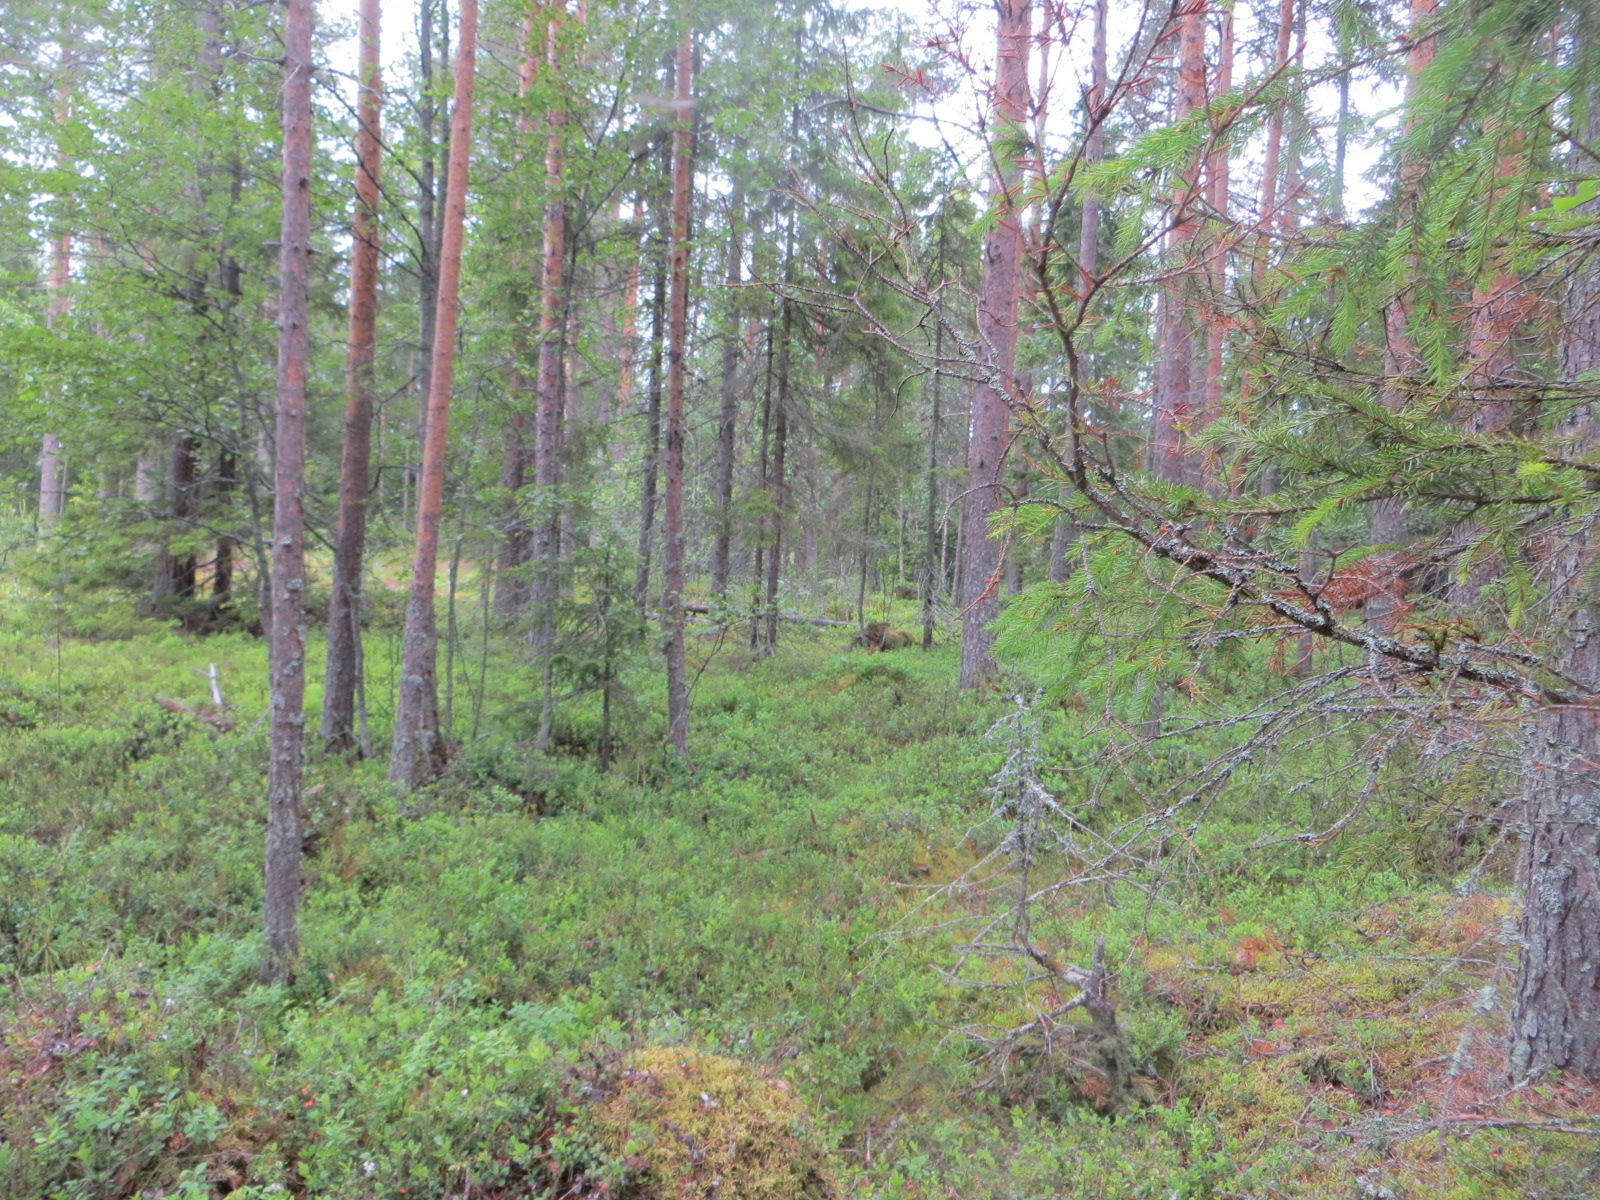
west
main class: Woodland
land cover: Pine dominated coniferous woodland
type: boreal forest
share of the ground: 50 - 75 %
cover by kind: coniferous forest trees 65 %, shrubs 30 %, broadleaved forest trees 5 %
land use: Forestry
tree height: > 5 m
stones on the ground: < 10 %
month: July
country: FI
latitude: 65.6383
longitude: 25.3902
